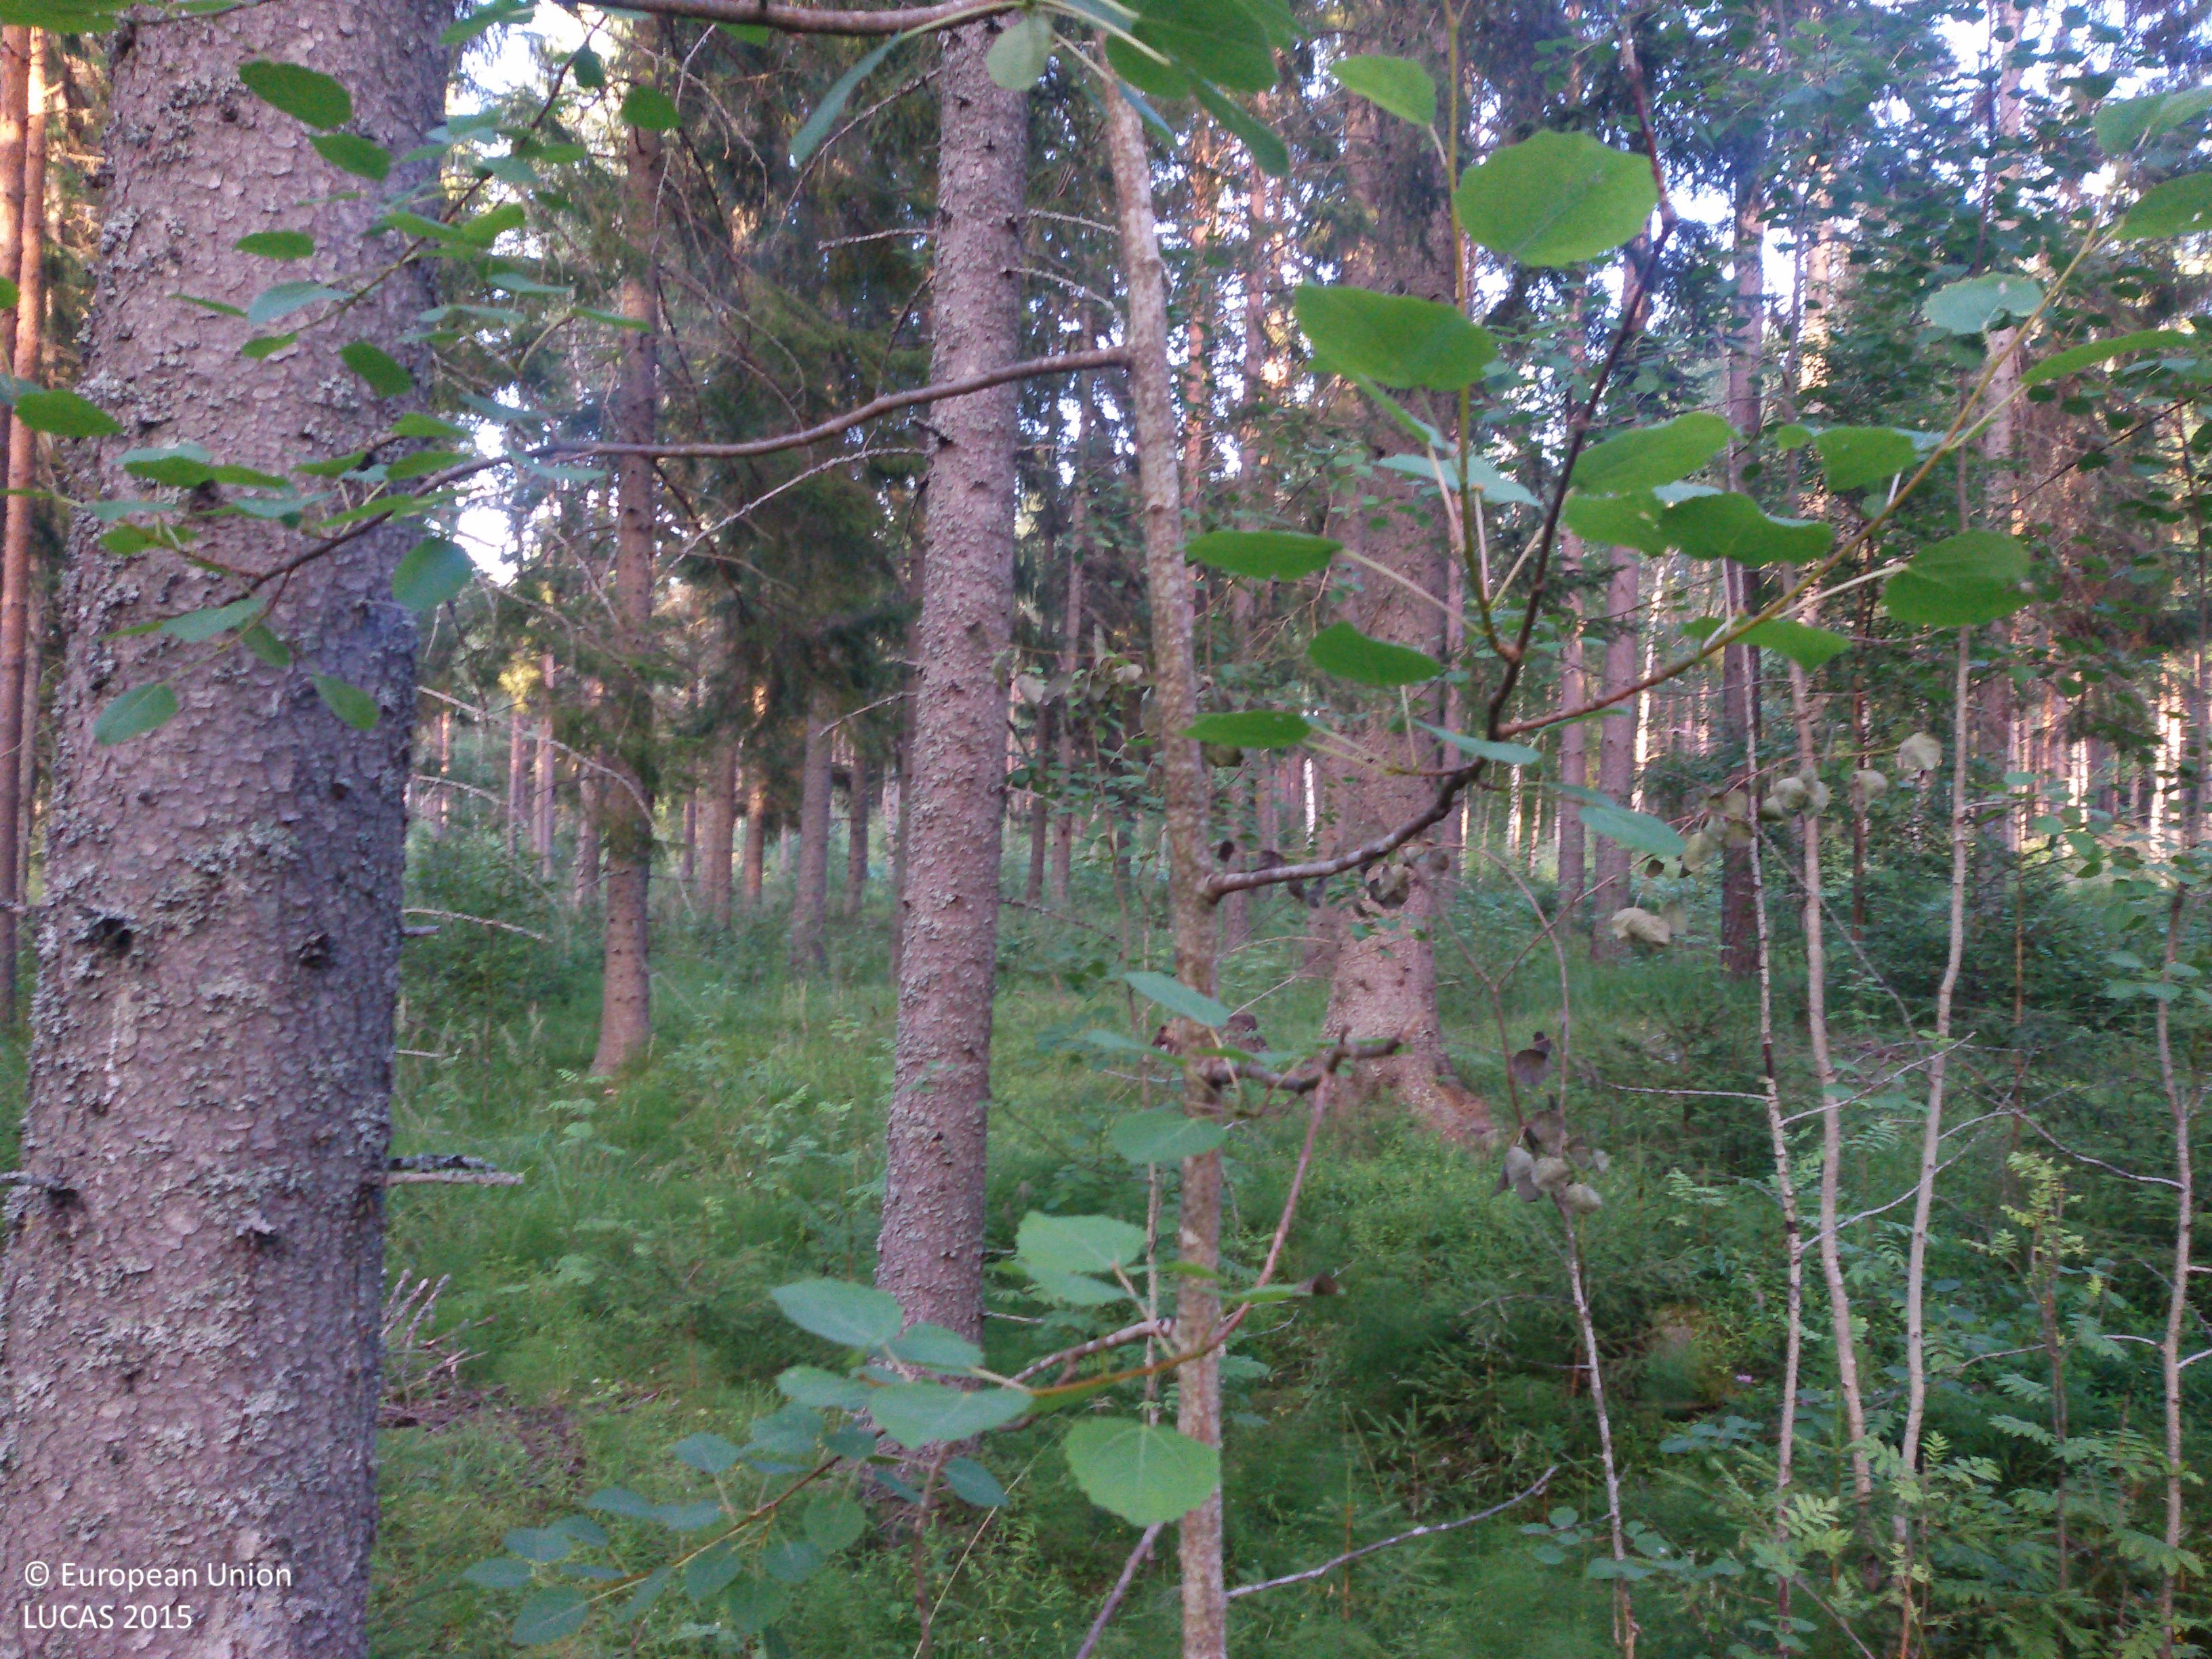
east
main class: Woodland
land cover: Spruce dominated coniferous woodland
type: boreal forest
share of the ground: 50 - 75 %
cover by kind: coniferous forest trees 60 %, herbaceous plants 20 %, broadleaved forest trees 10 %, lichens and mosses 10 %
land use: Forestry
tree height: > 5 m
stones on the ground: < 10 %
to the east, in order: Spruce dominated coniferous woodland; Paved roads, cycling and walking lanes; Pine dominated coniferous woodland
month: August
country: SE
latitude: 60.4408
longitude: 16.6219
